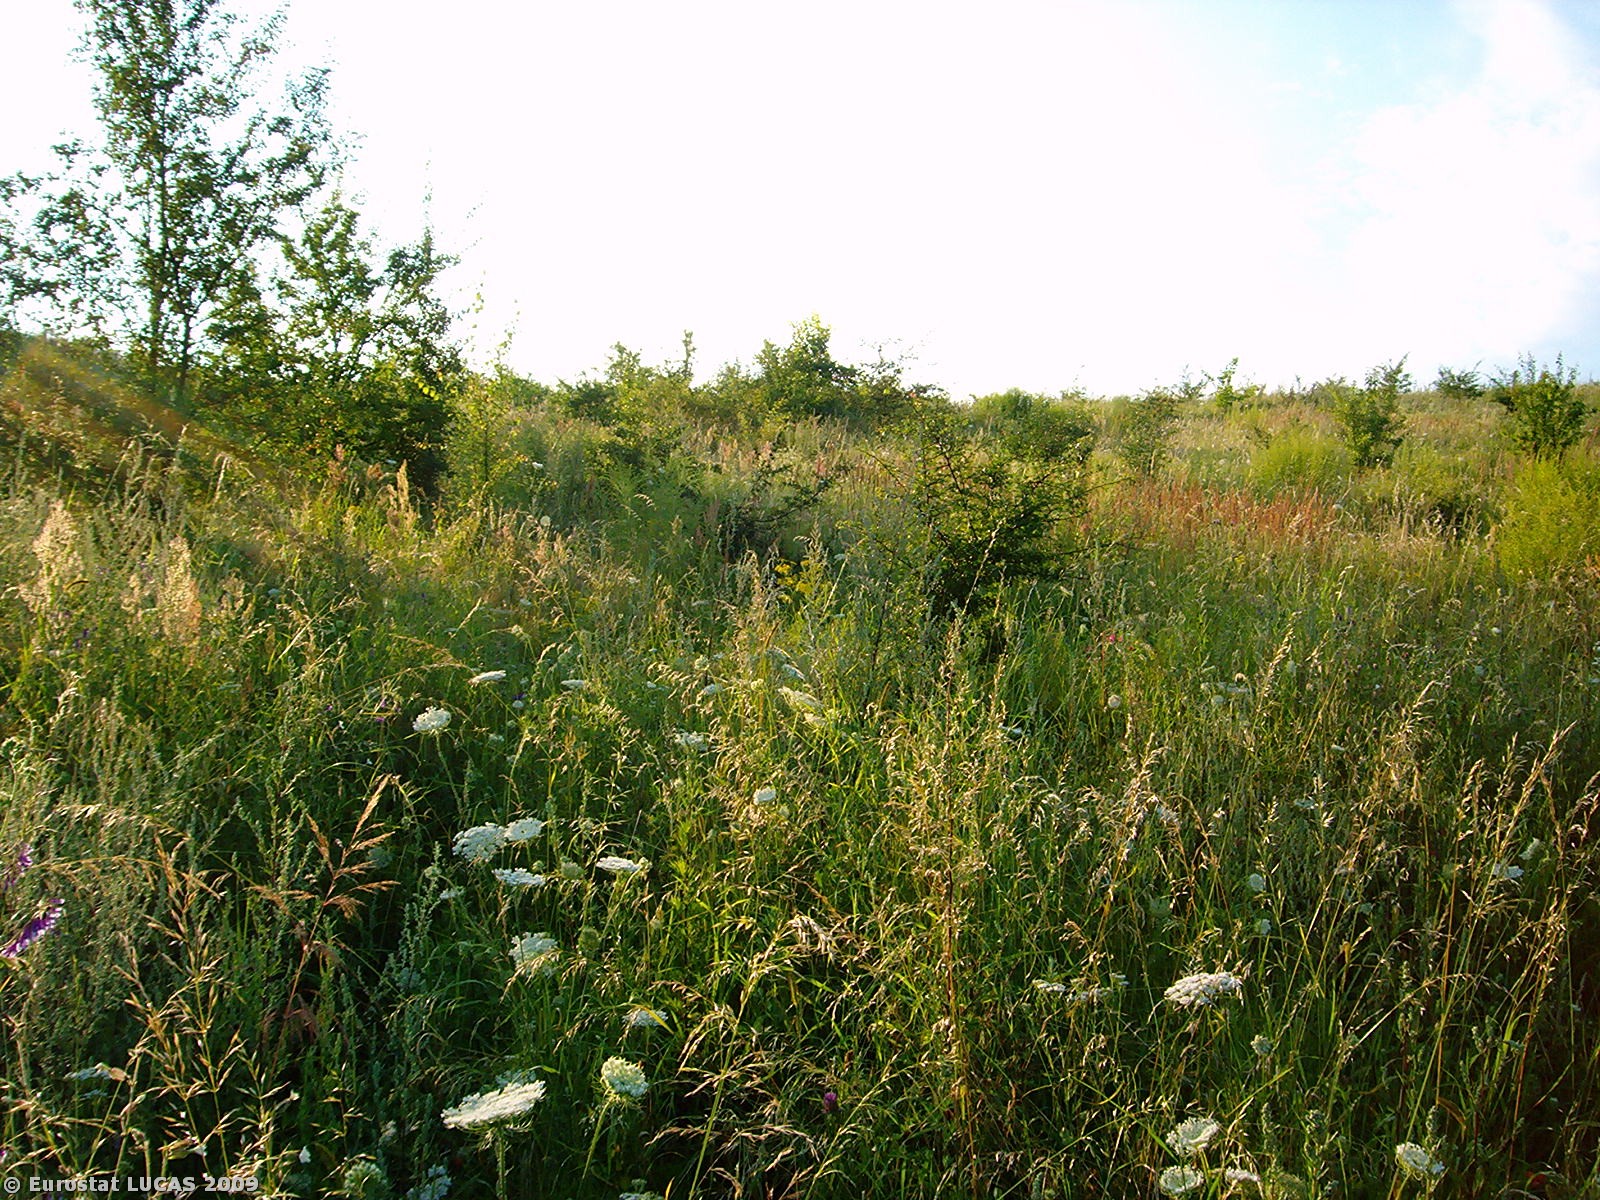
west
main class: Grassland
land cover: Grassland with sparse tree/shrub cover
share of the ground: > 75 %
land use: Unused
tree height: < 5 m
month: July
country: PL
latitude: 52.7406
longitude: 15.4099
